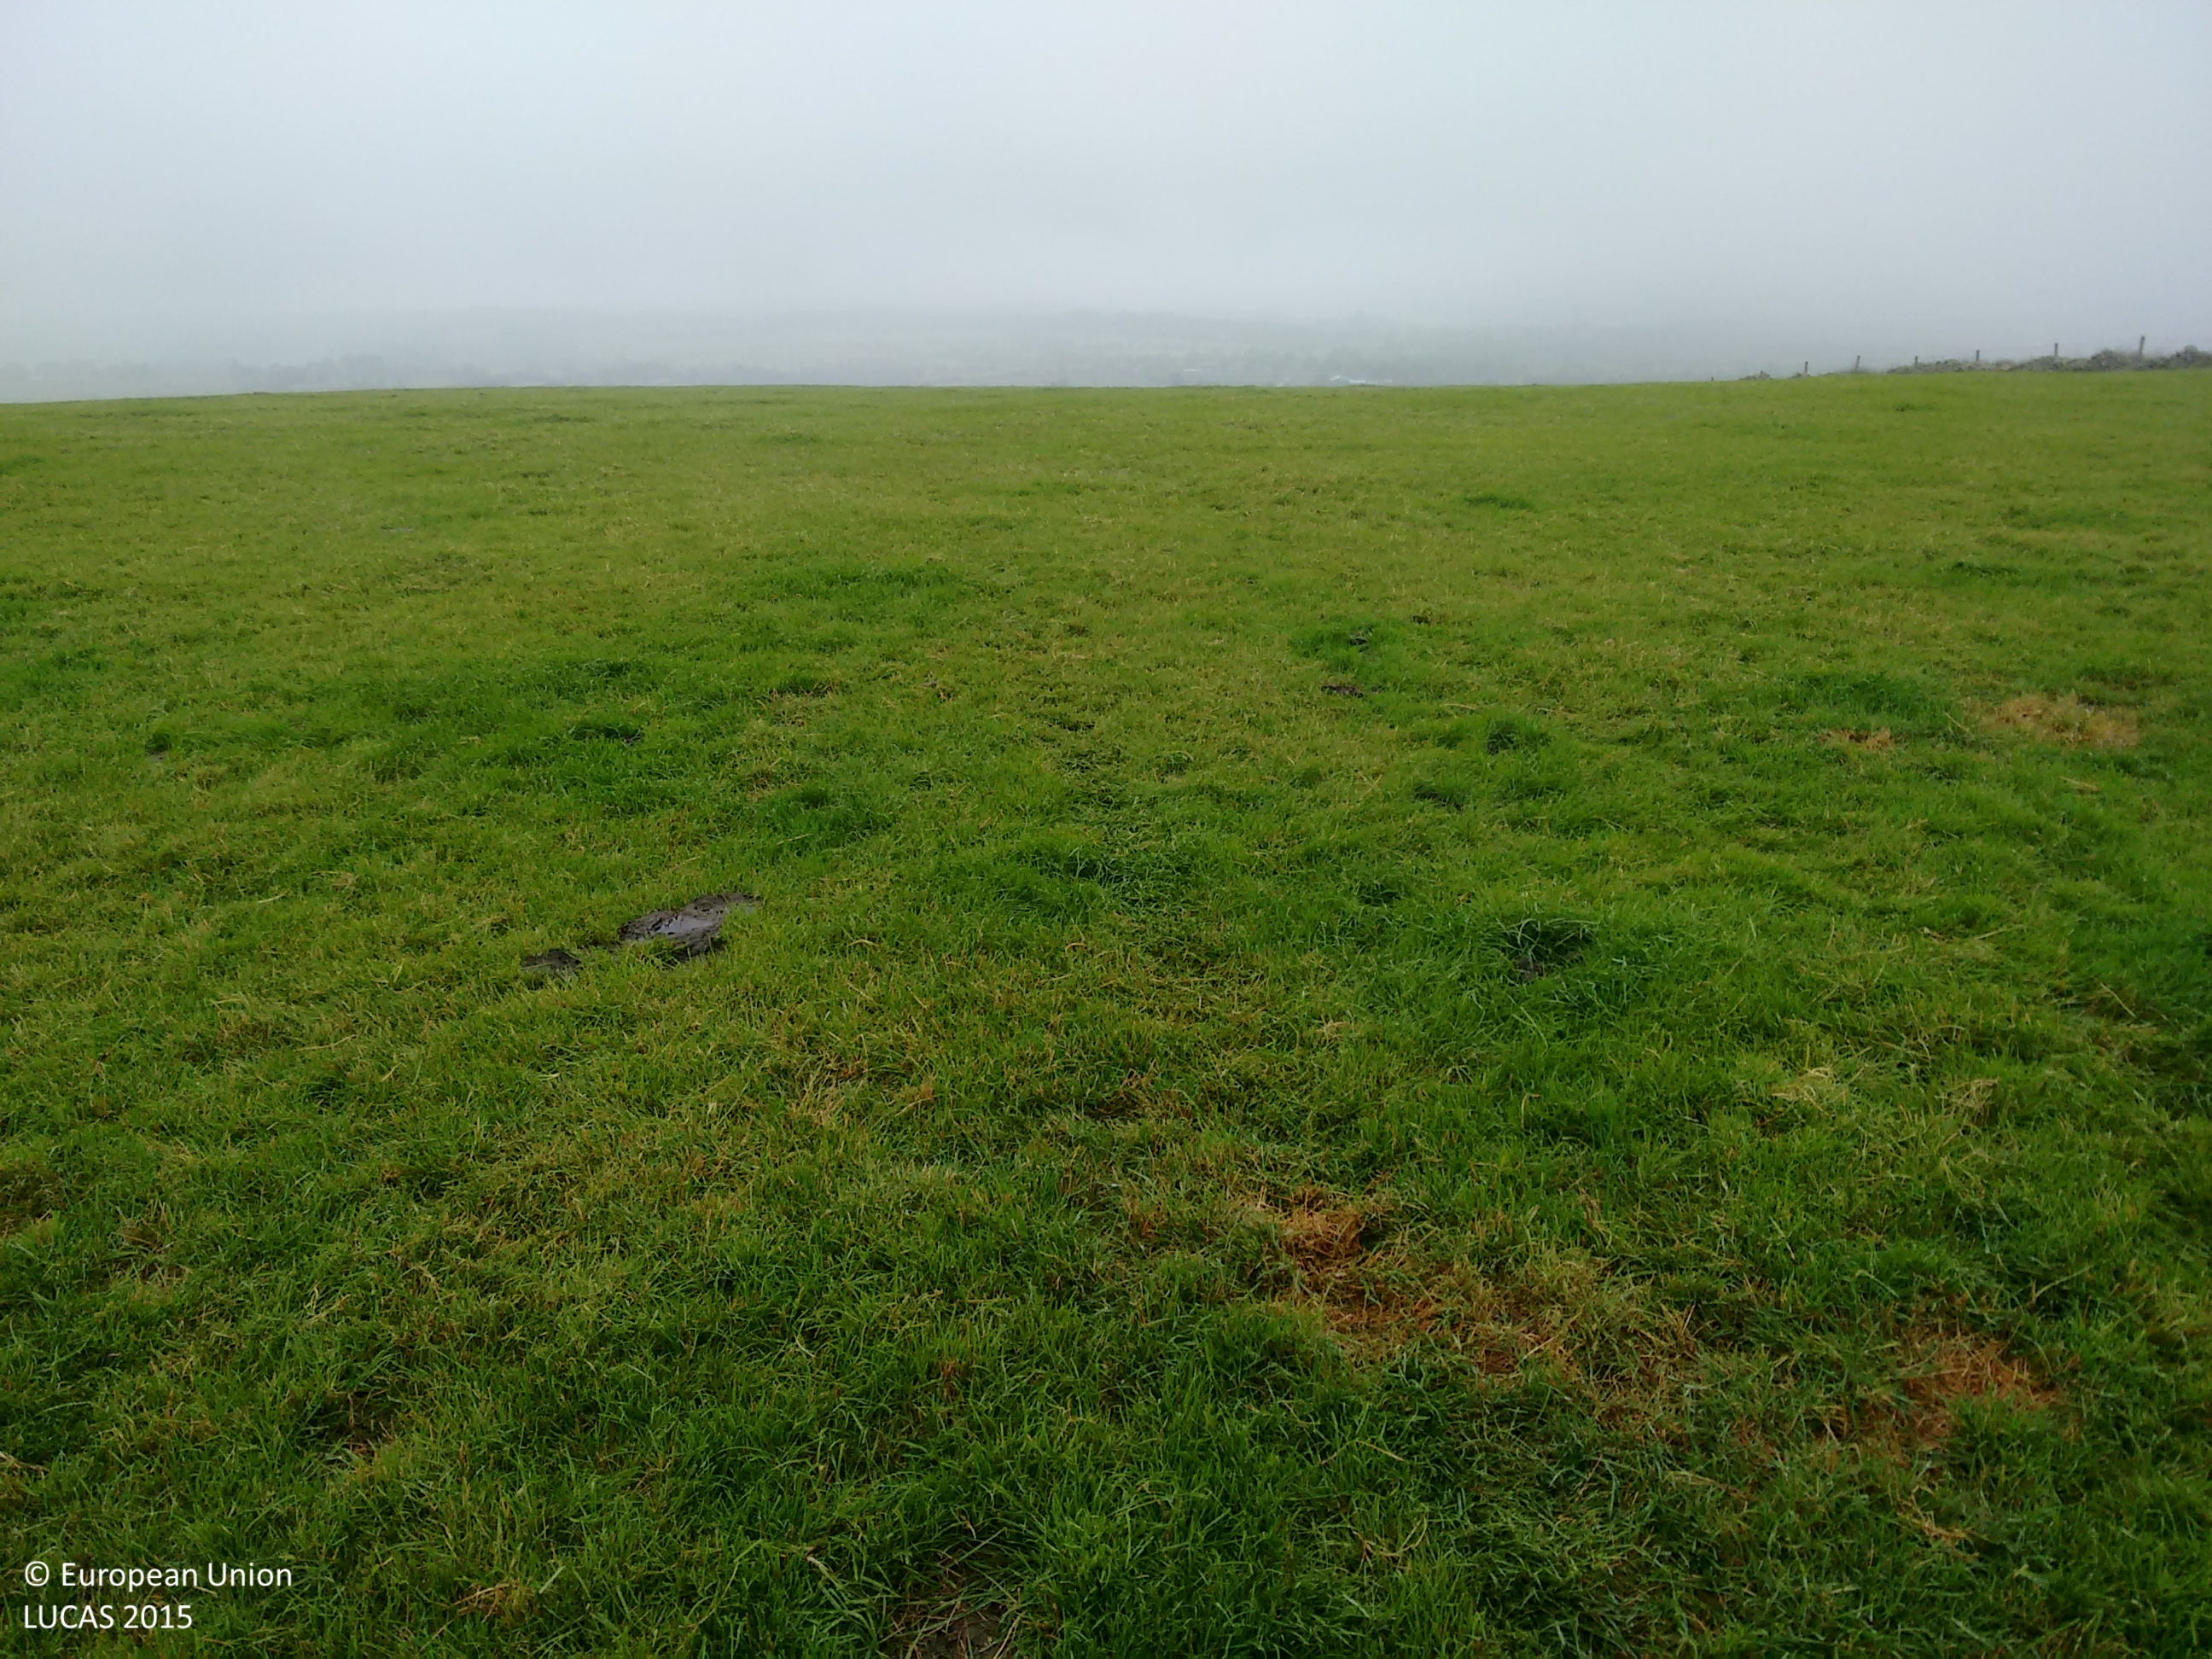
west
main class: Grassland
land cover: Grassland without tree/shrub cover
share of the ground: > 75 %
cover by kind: herbaceous plants 100 %
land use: Agriculture (excluding fallow land and kitchen gardens)
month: July
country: GB
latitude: 53.1153
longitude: -1.9648
